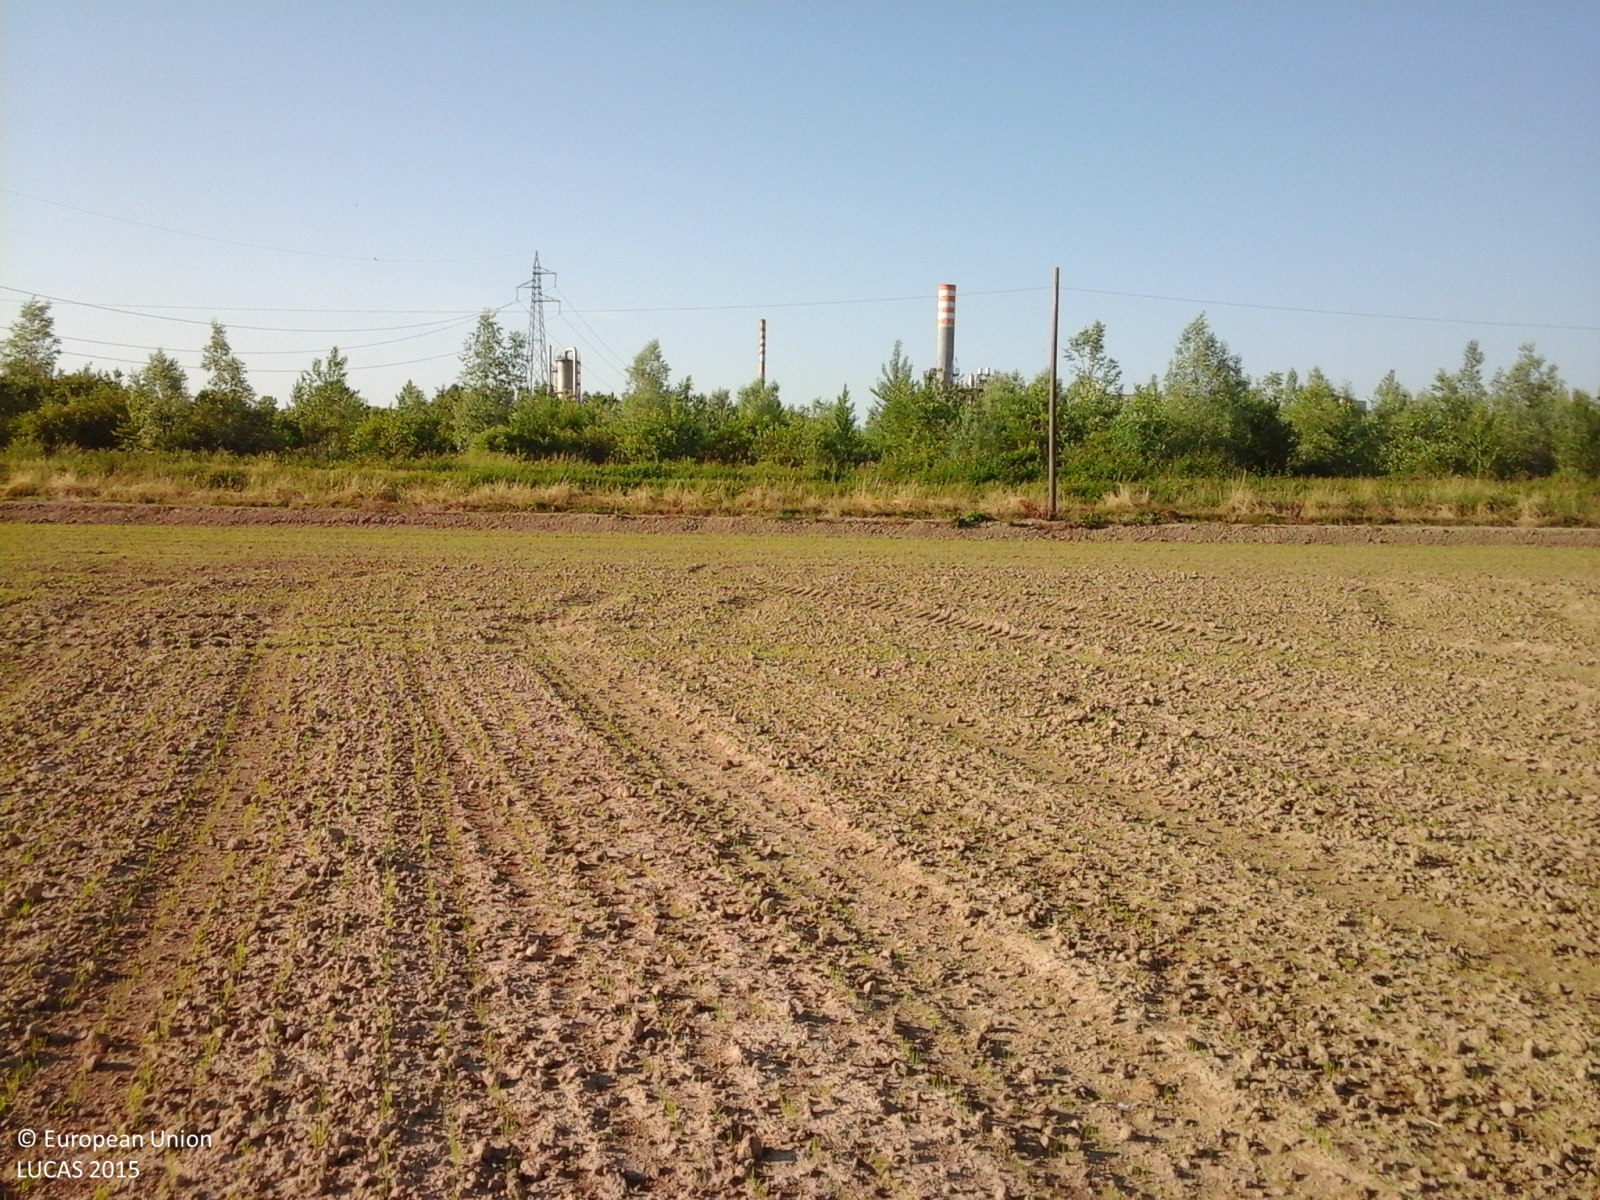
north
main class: Cropland
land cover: Rice
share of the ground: < 10 %
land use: Agriculture (excluding fallow land and kitchen gardens)
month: May
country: IT
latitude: 45.2941
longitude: 8.4089
